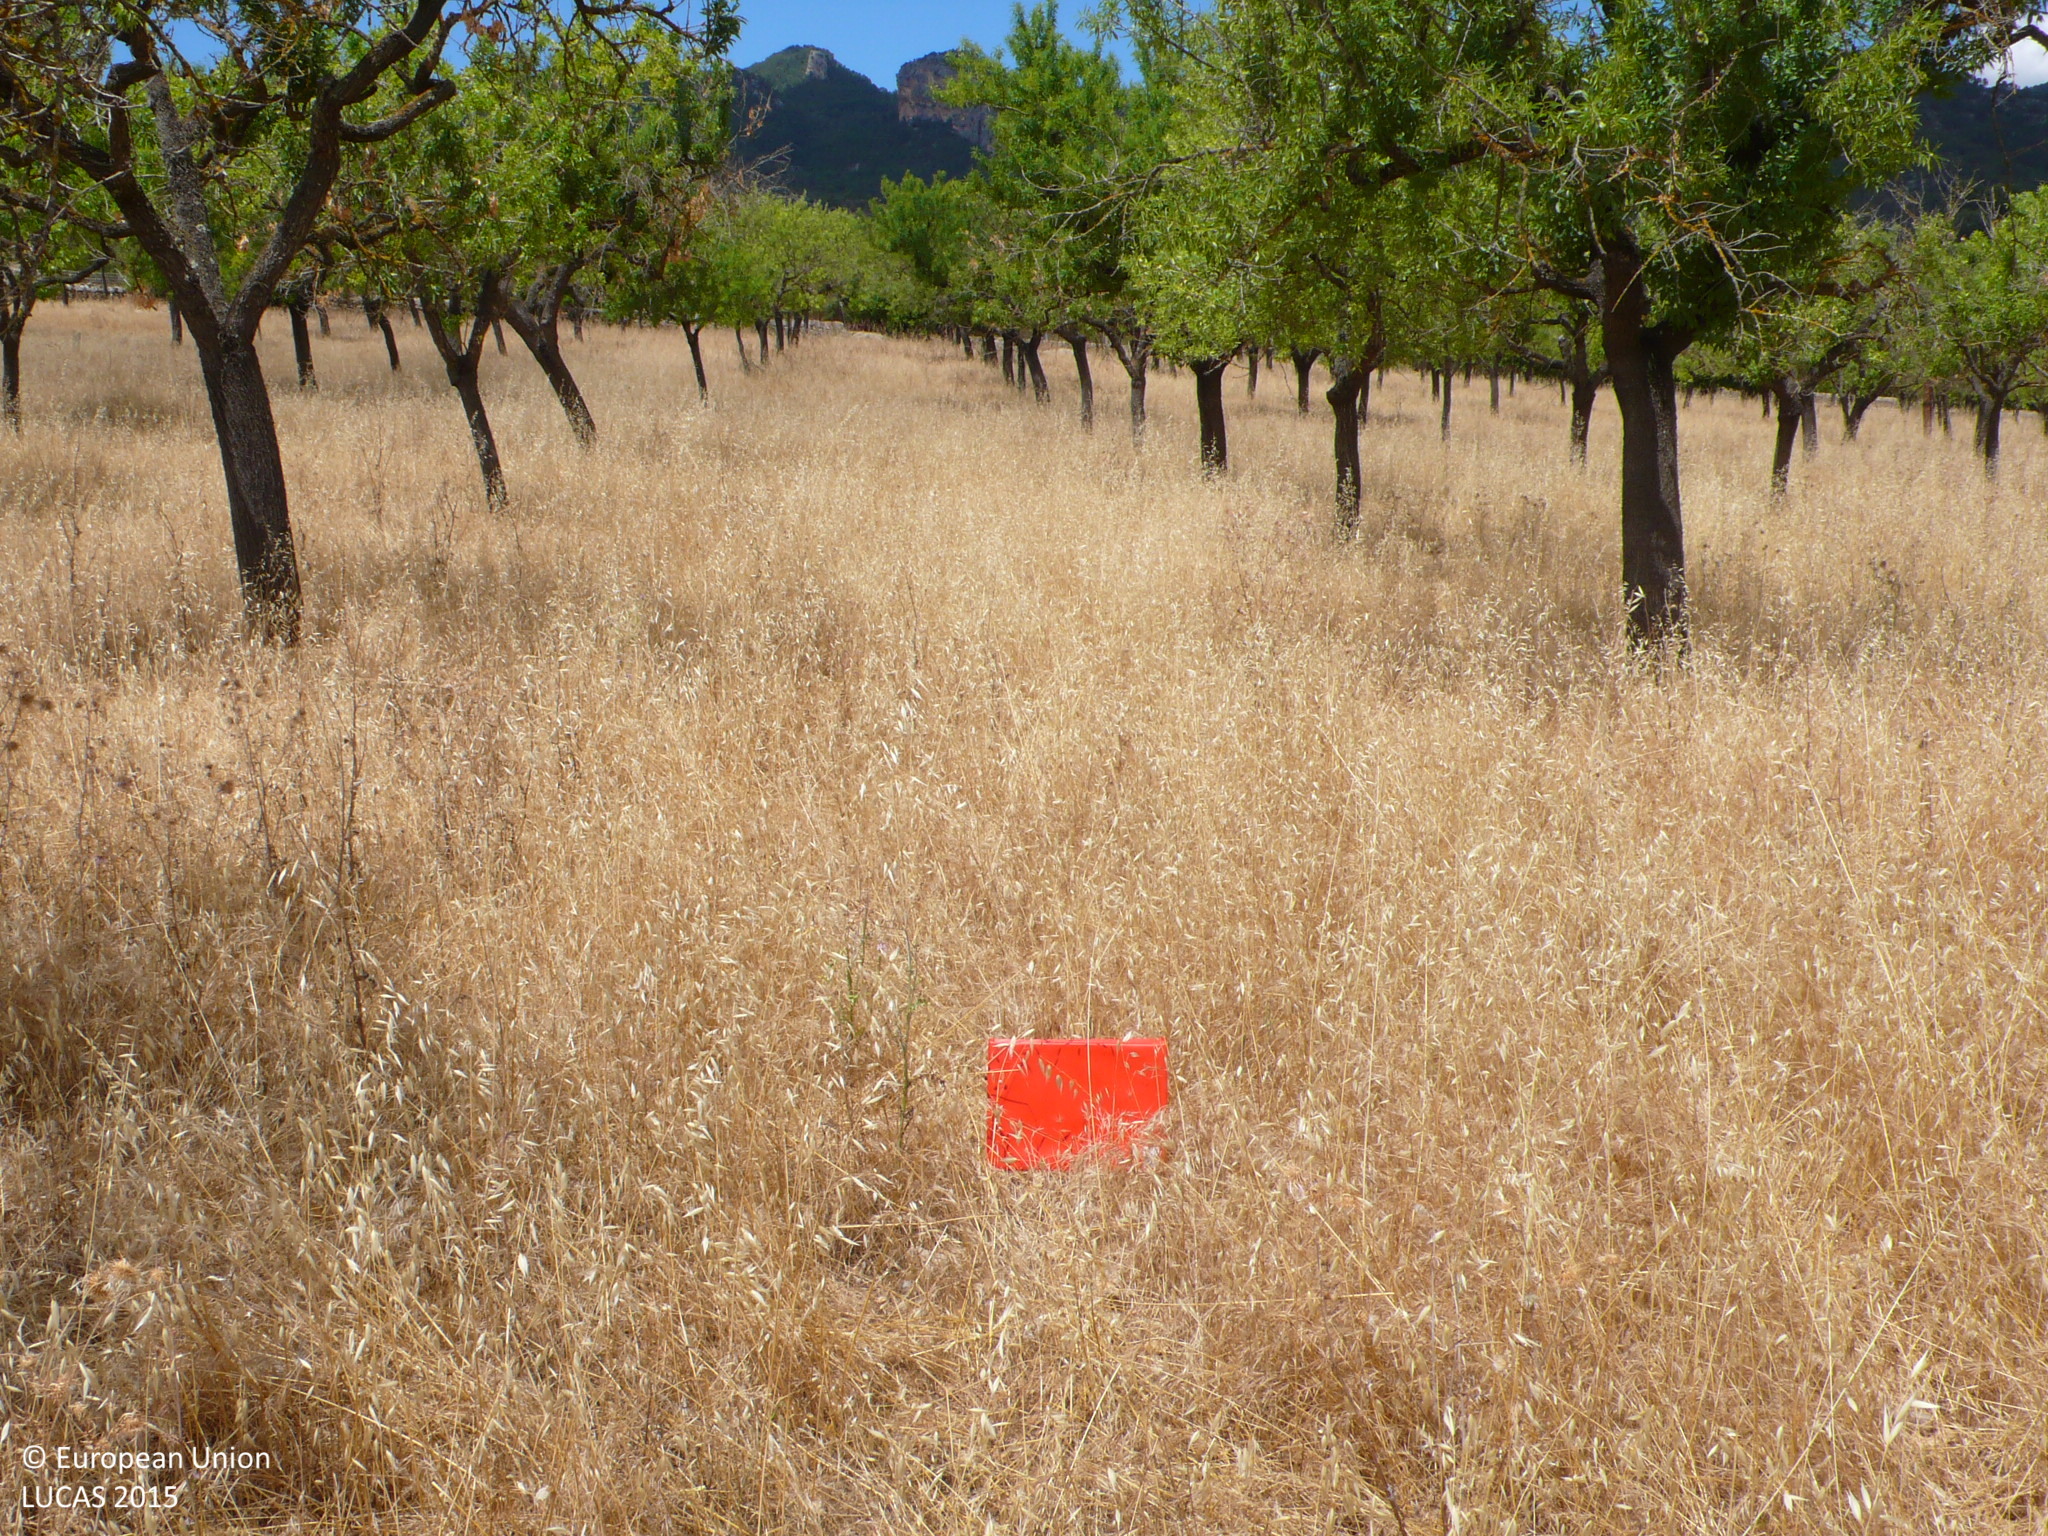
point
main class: Cropland
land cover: Nuts trees
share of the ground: 50 - 75 %
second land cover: Spontaneously vegetated surfaces
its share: > 75 %
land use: Agriculture (excluding fallow land and kitchen gardens)
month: June
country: ES
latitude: 39.6928
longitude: 2.7880
